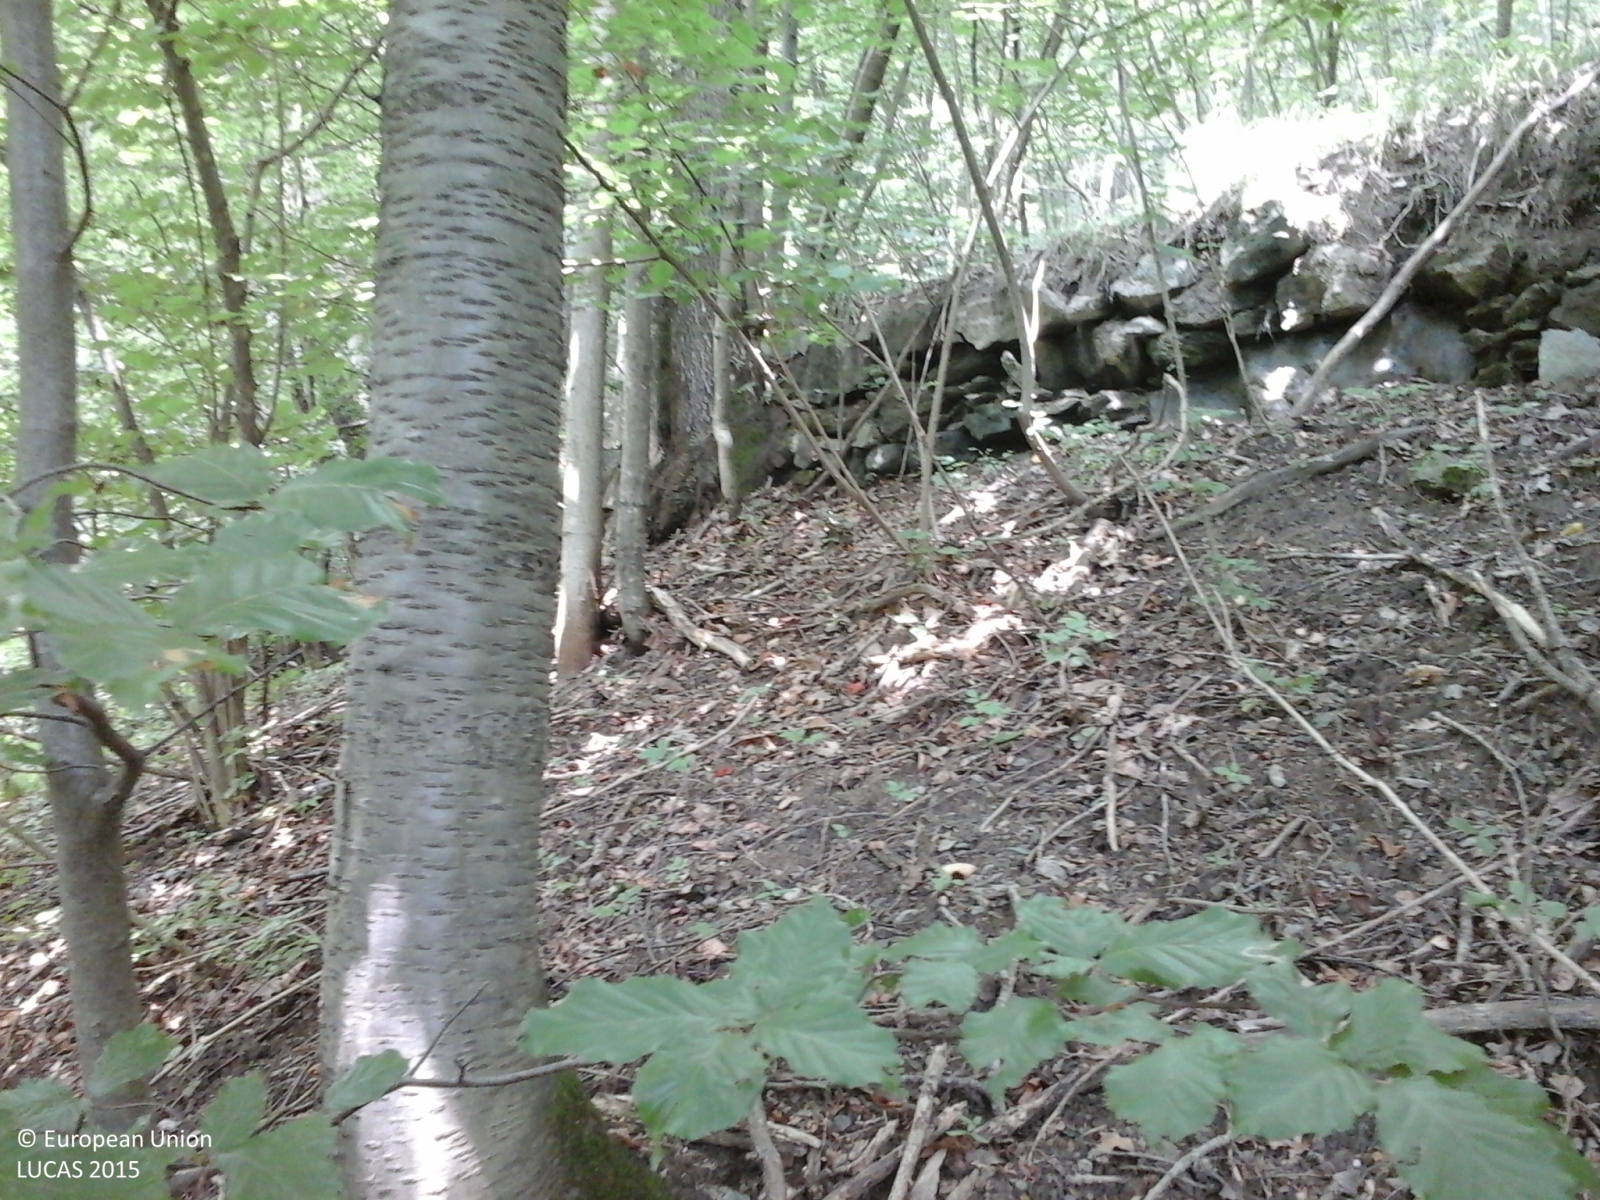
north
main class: Woodland
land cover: Broadleaved woodland
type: beech forest
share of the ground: > 75 %
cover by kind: broadleaved forest trees 100 %
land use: Semi-natural and natural areas not in use
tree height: > 5 m
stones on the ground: 10 - 25 %
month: July
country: IT
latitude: 45.2353
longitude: 7.2911
